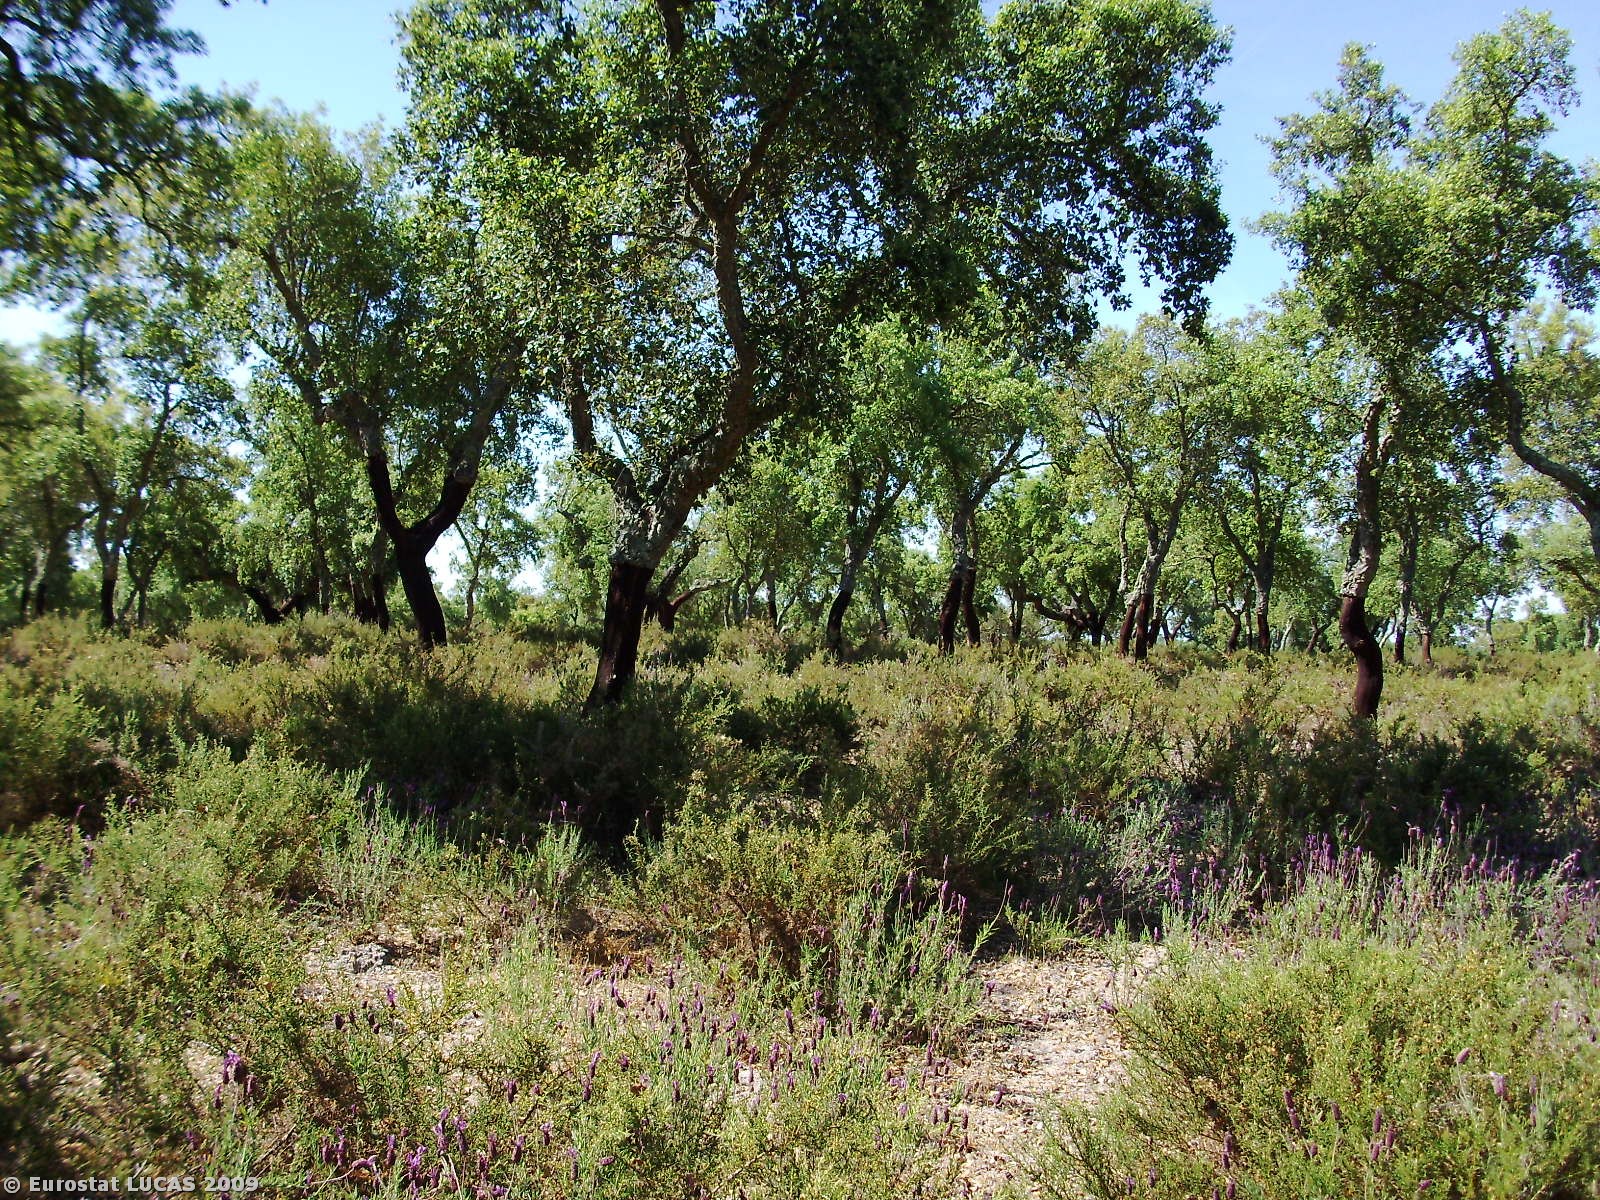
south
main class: Woodland
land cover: Broadleaved woodland
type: broadleaved evergreen forest
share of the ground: 50 - 75 %
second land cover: Shrubland with sparse tree cover
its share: 25 - 50 %
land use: Forestry
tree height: > 5 m
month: May
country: PT
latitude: 39.1941
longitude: -7.9169
